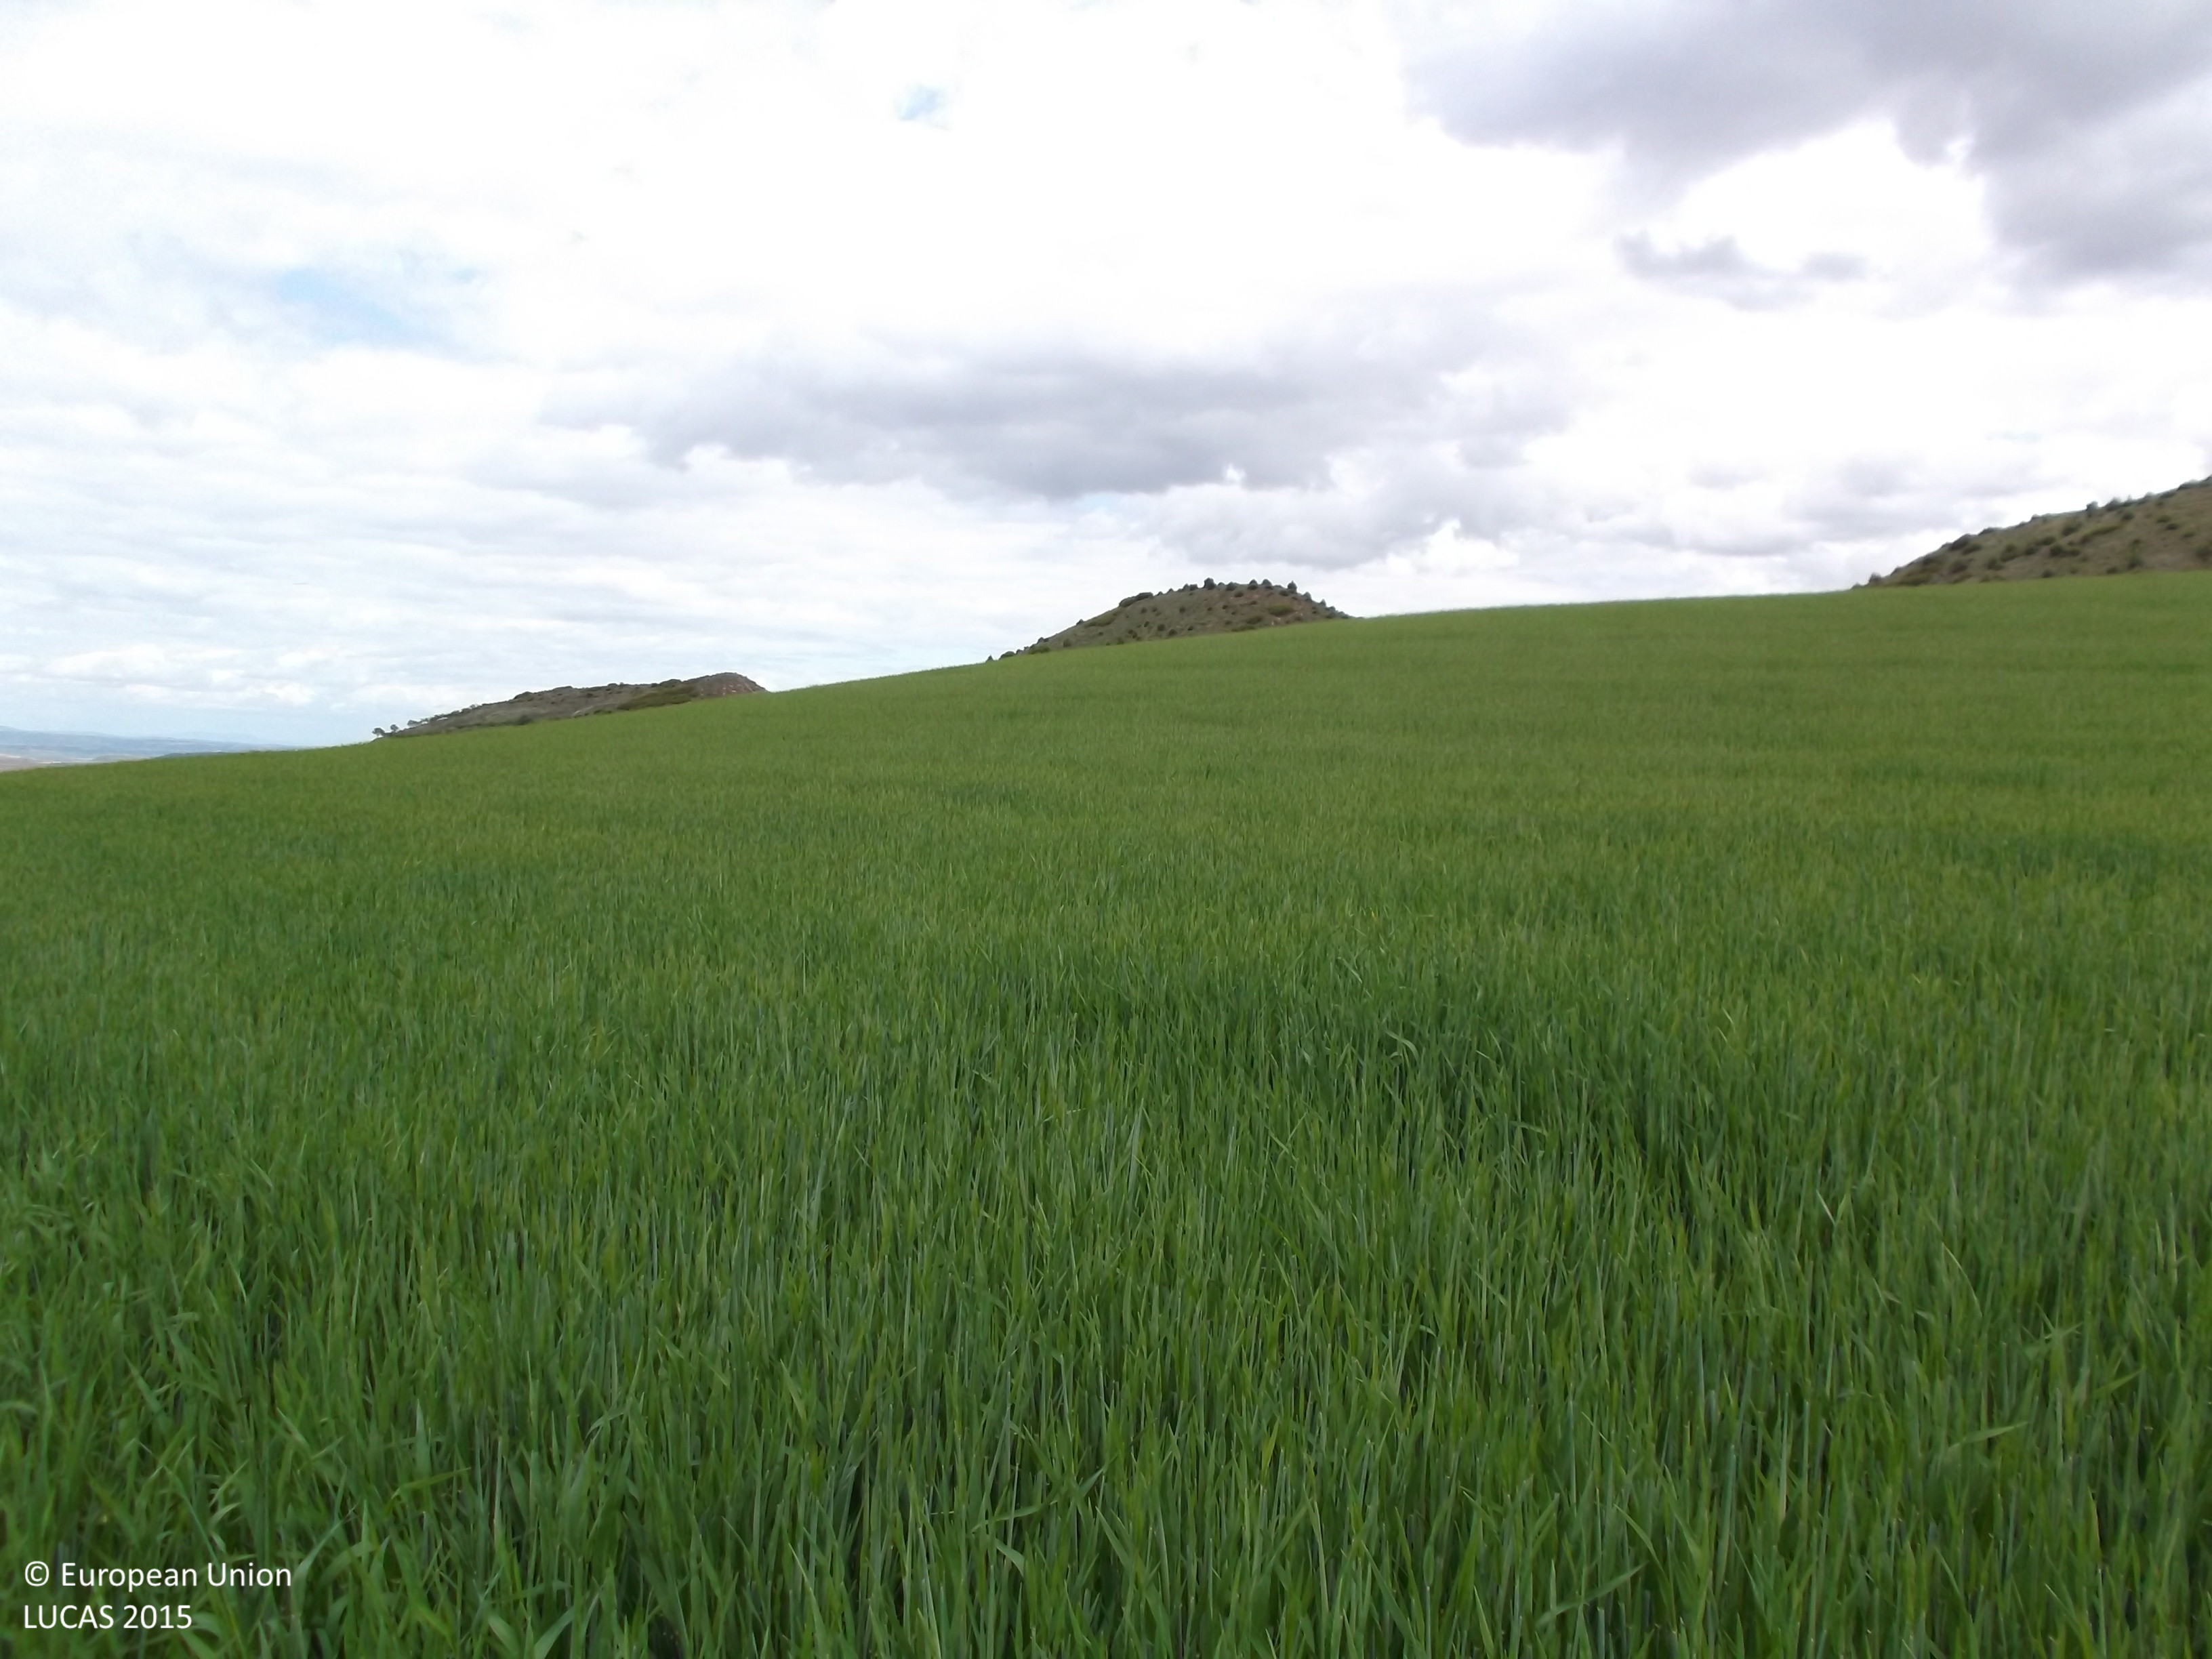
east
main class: Cropland
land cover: Barley
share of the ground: > 75 %
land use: Agriculture (excluding fallow land and kitchen gardens)
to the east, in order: Barley
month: May
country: ES
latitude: 42.3792
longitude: -2.4196
